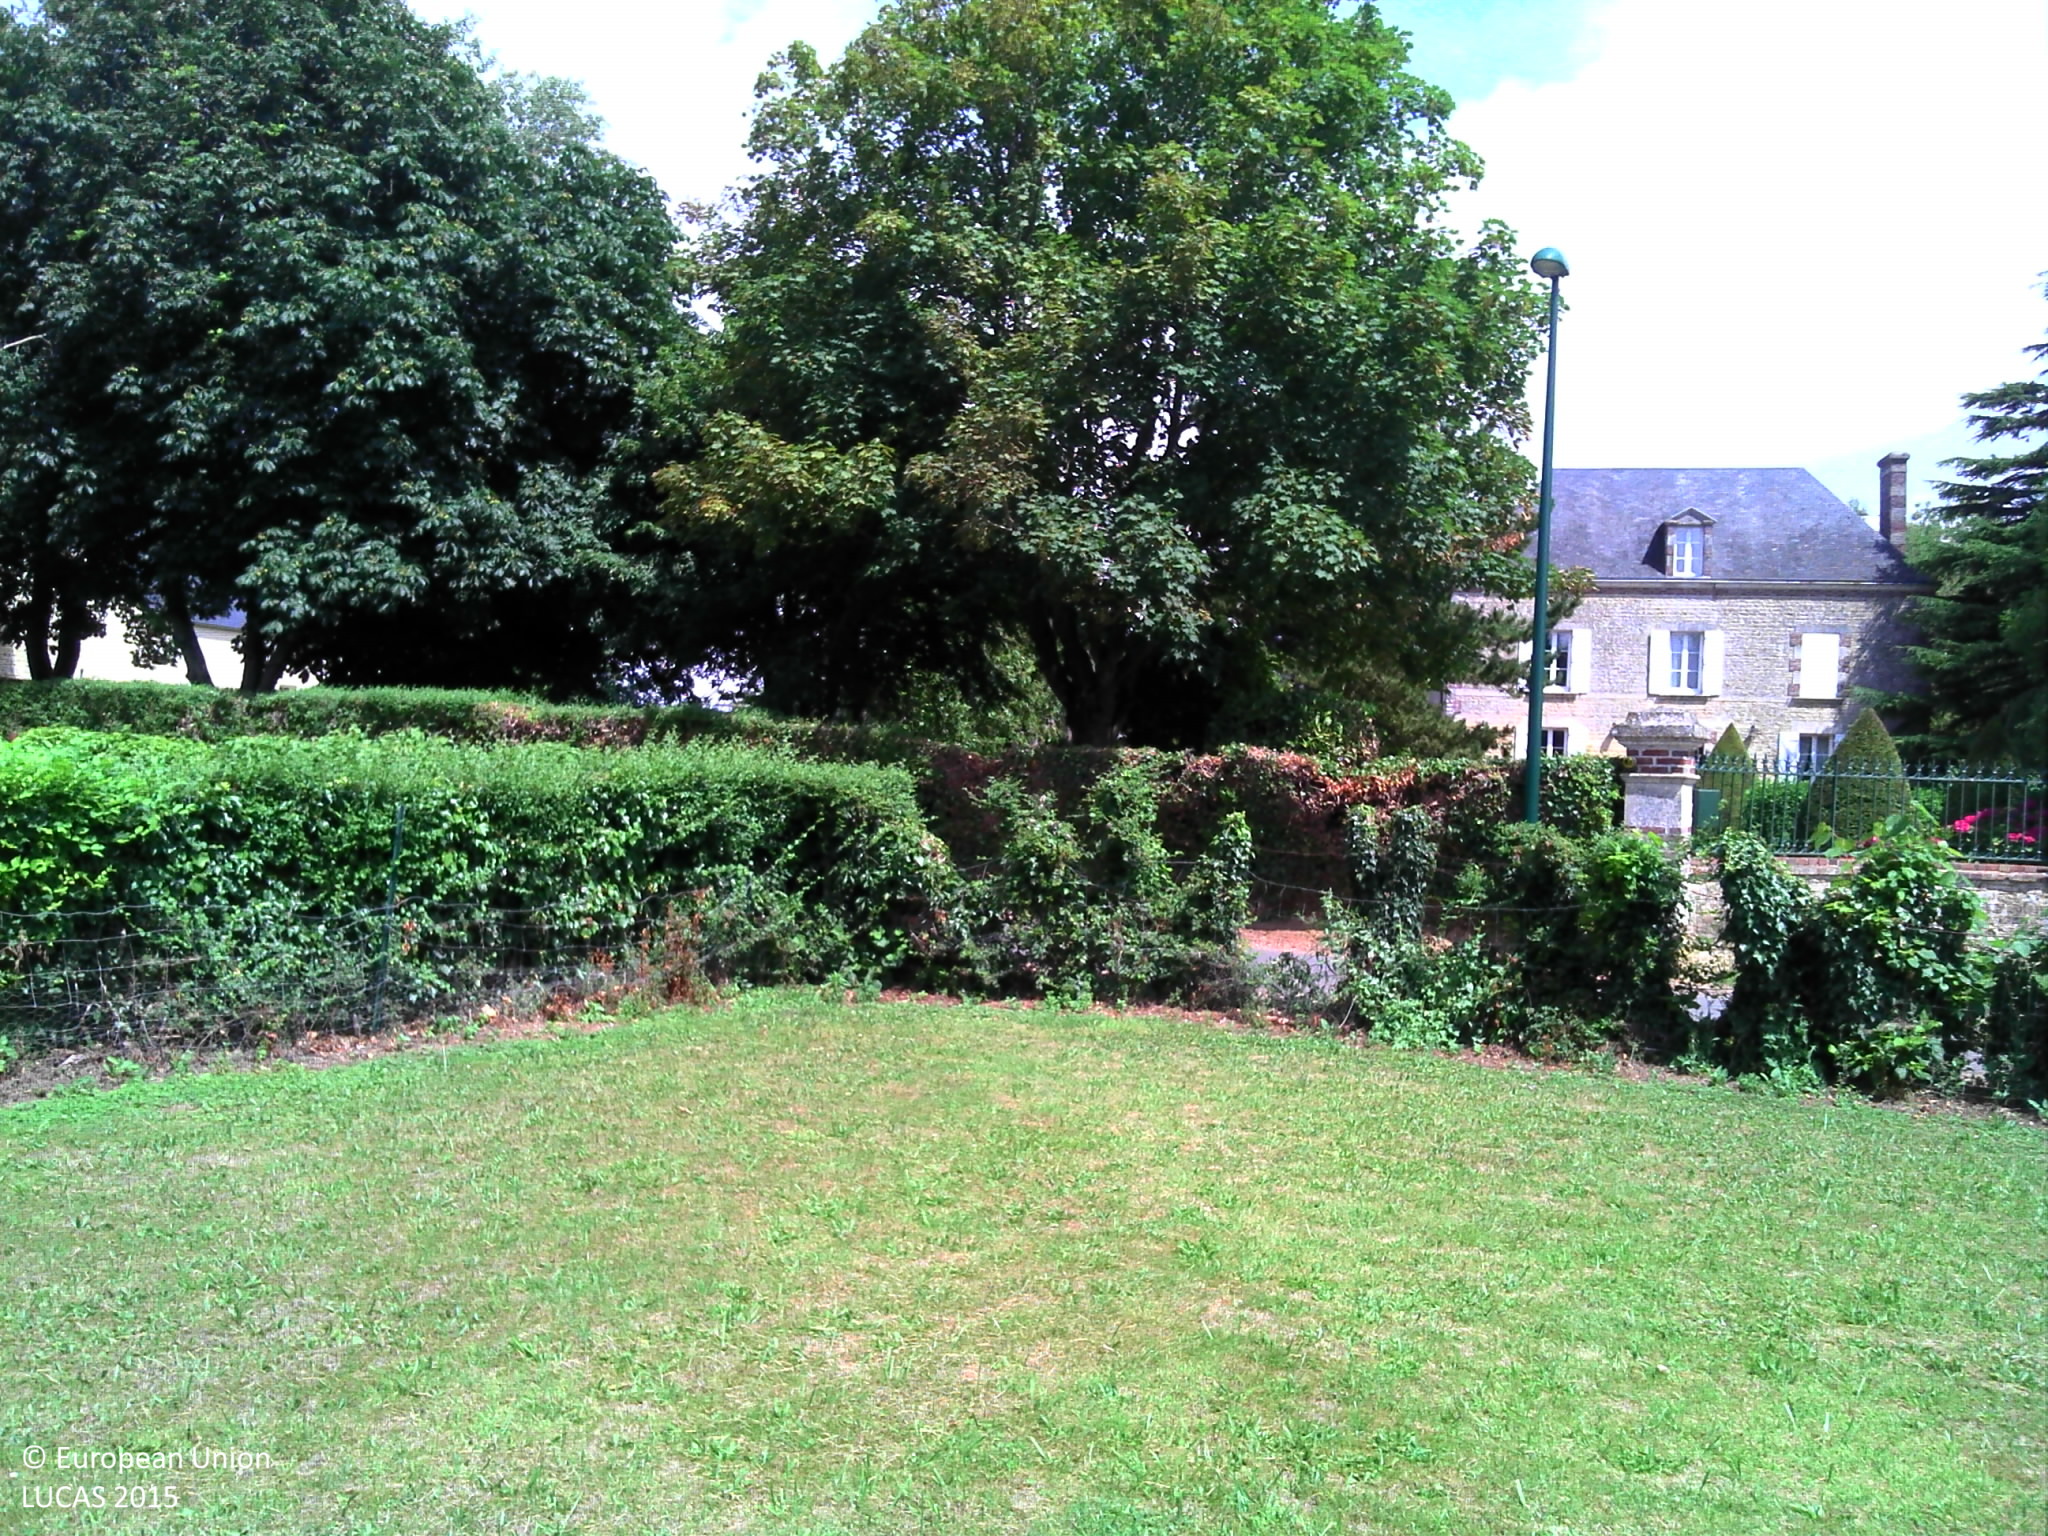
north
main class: Grassland
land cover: Grassland without tree/shrub cover
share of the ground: > 75 %
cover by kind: herbaceous plants 100 %
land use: Residential
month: July
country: FR
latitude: 48.9559
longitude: -0.2899
